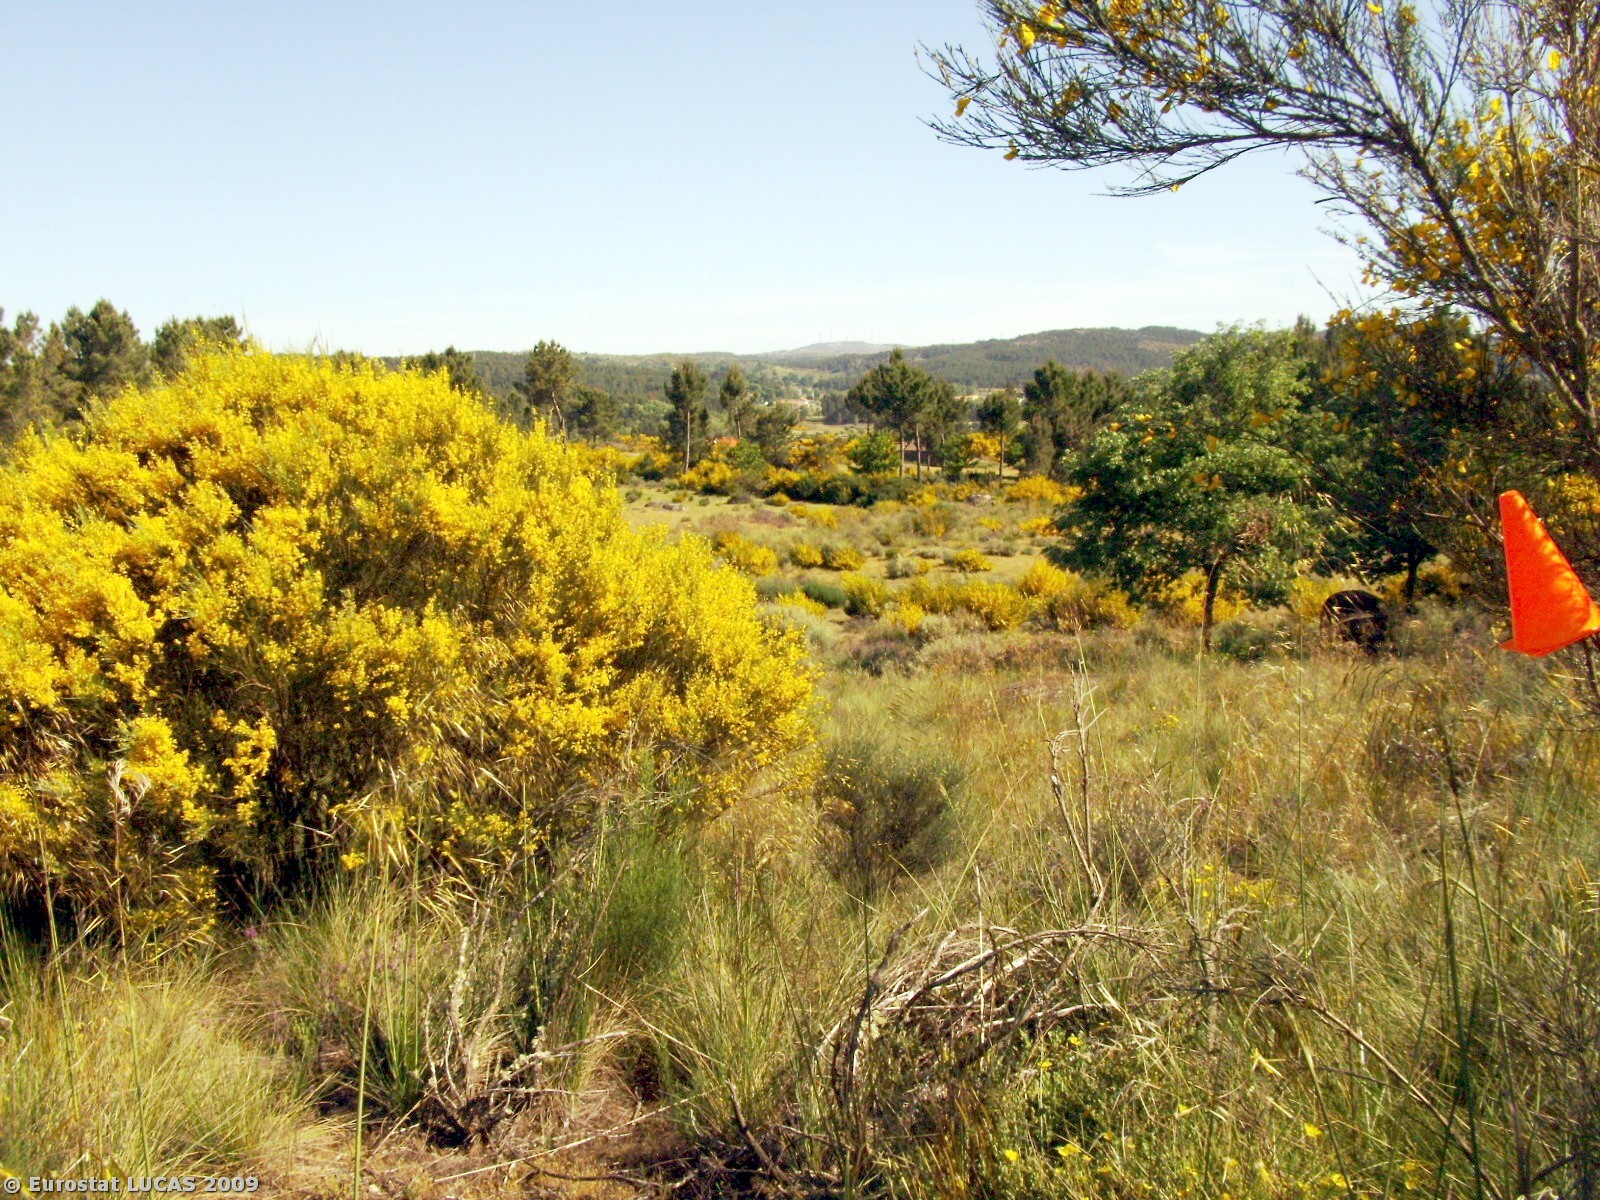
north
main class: Shrubland
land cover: Shrubland with sparse tree cover
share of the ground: > 75 %
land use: Unused
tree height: > 5 m
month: May
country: PT
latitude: 40.7660
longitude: -7.3971
